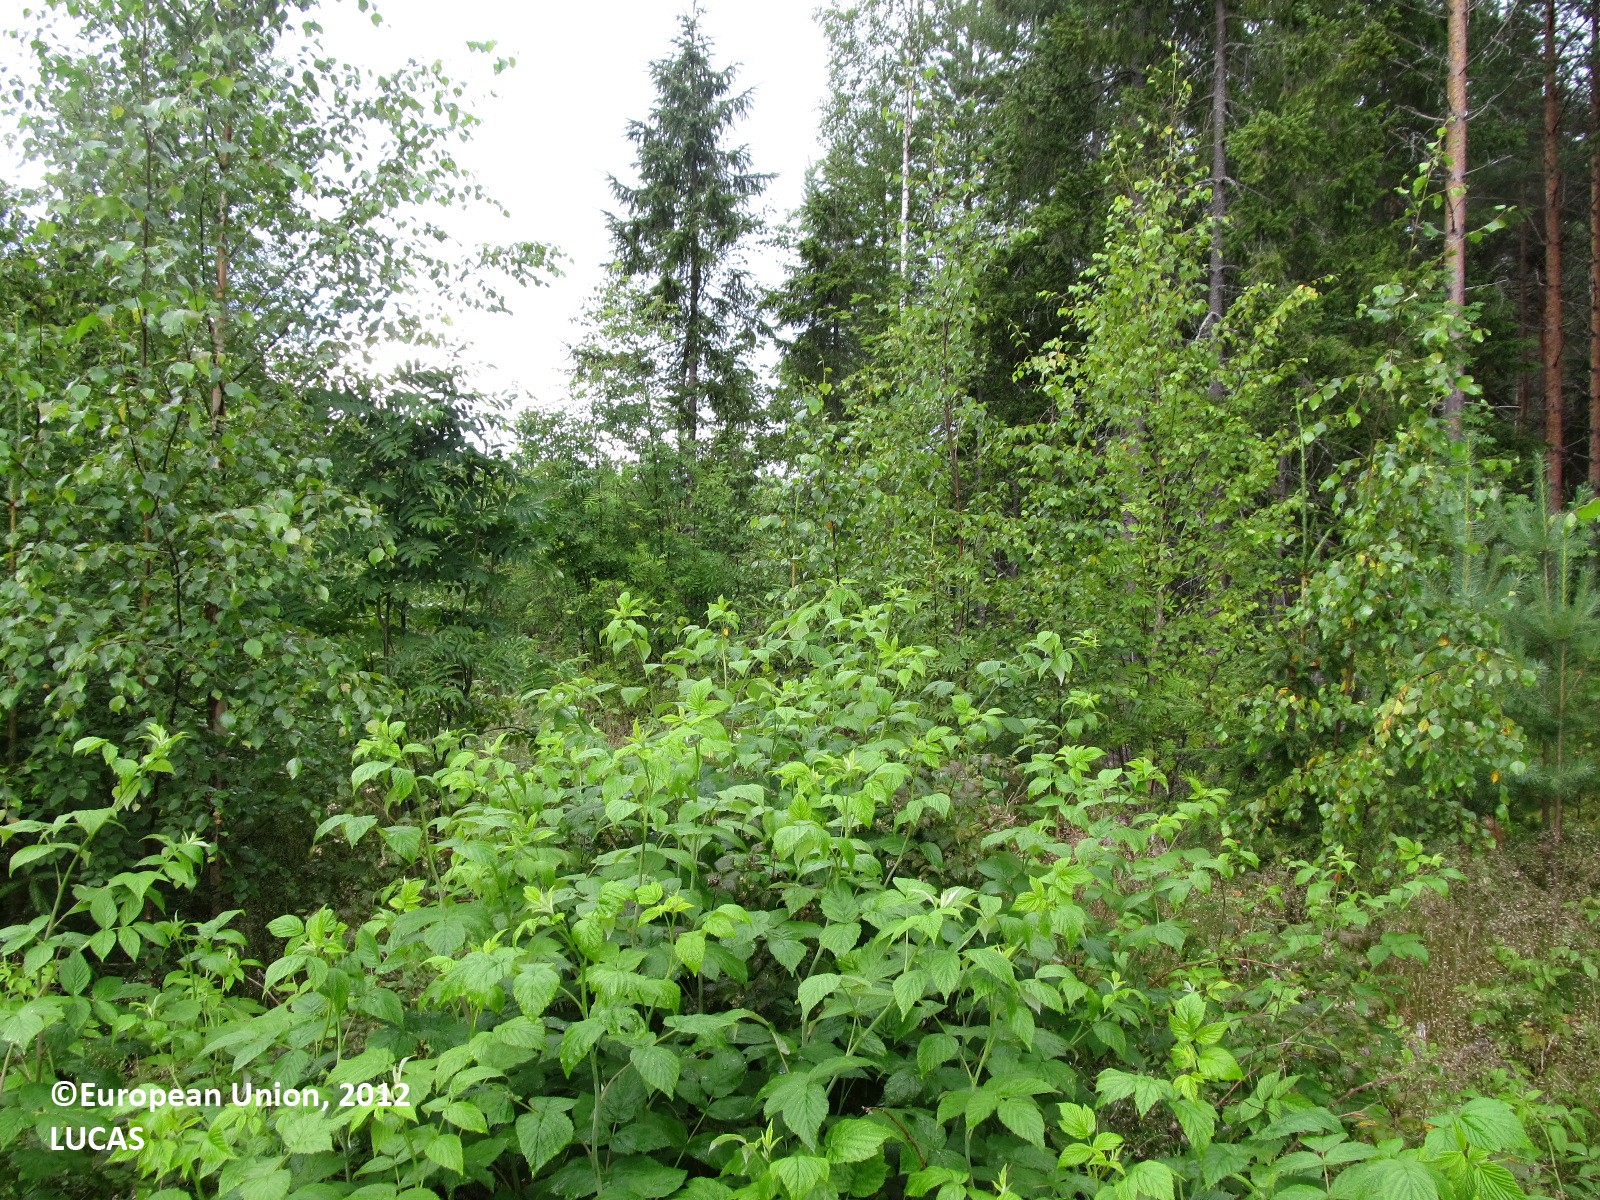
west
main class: Woodland
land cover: Broadleaved woodland
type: boreal forest
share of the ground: 25 - 50 %
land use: Forestry
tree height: < 5 m
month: July
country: FI
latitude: 62.0234
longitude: 28.3741
